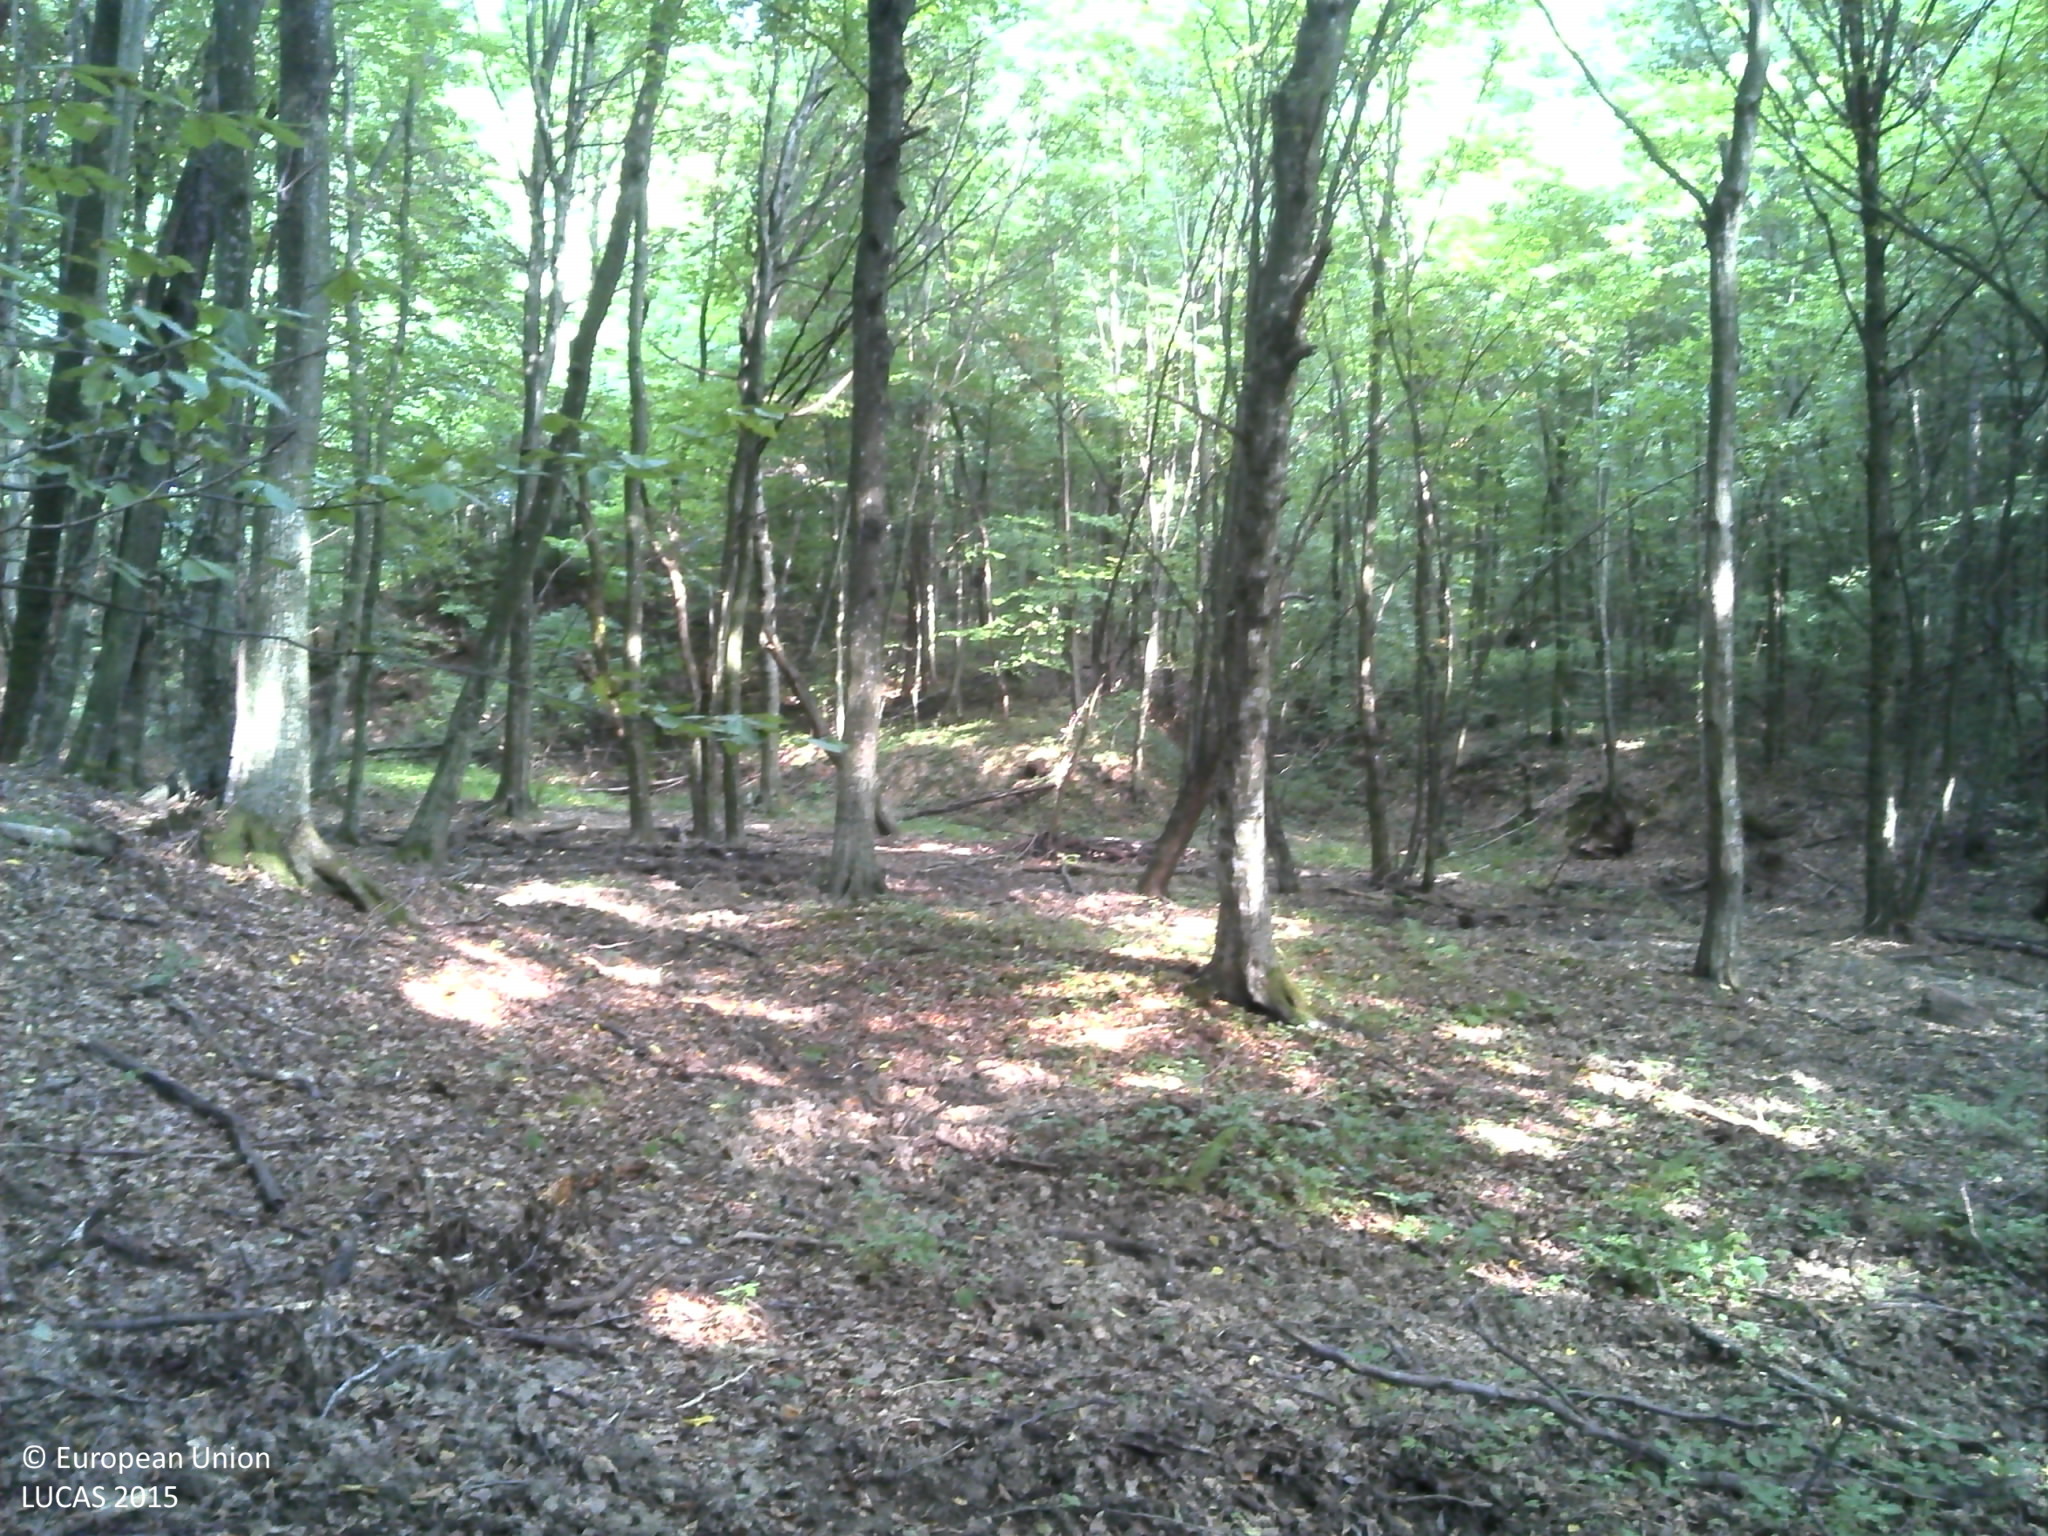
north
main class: Woodland
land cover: Broadleaved woodland
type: acidophilous oak and oak-birch forest
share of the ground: > 75 %
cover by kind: broadleaved forest trees 100 %
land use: Forestry
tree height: > 5 m
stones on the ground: < 10 %
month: September
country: HR
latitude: 45.7353
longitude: 16.5403
